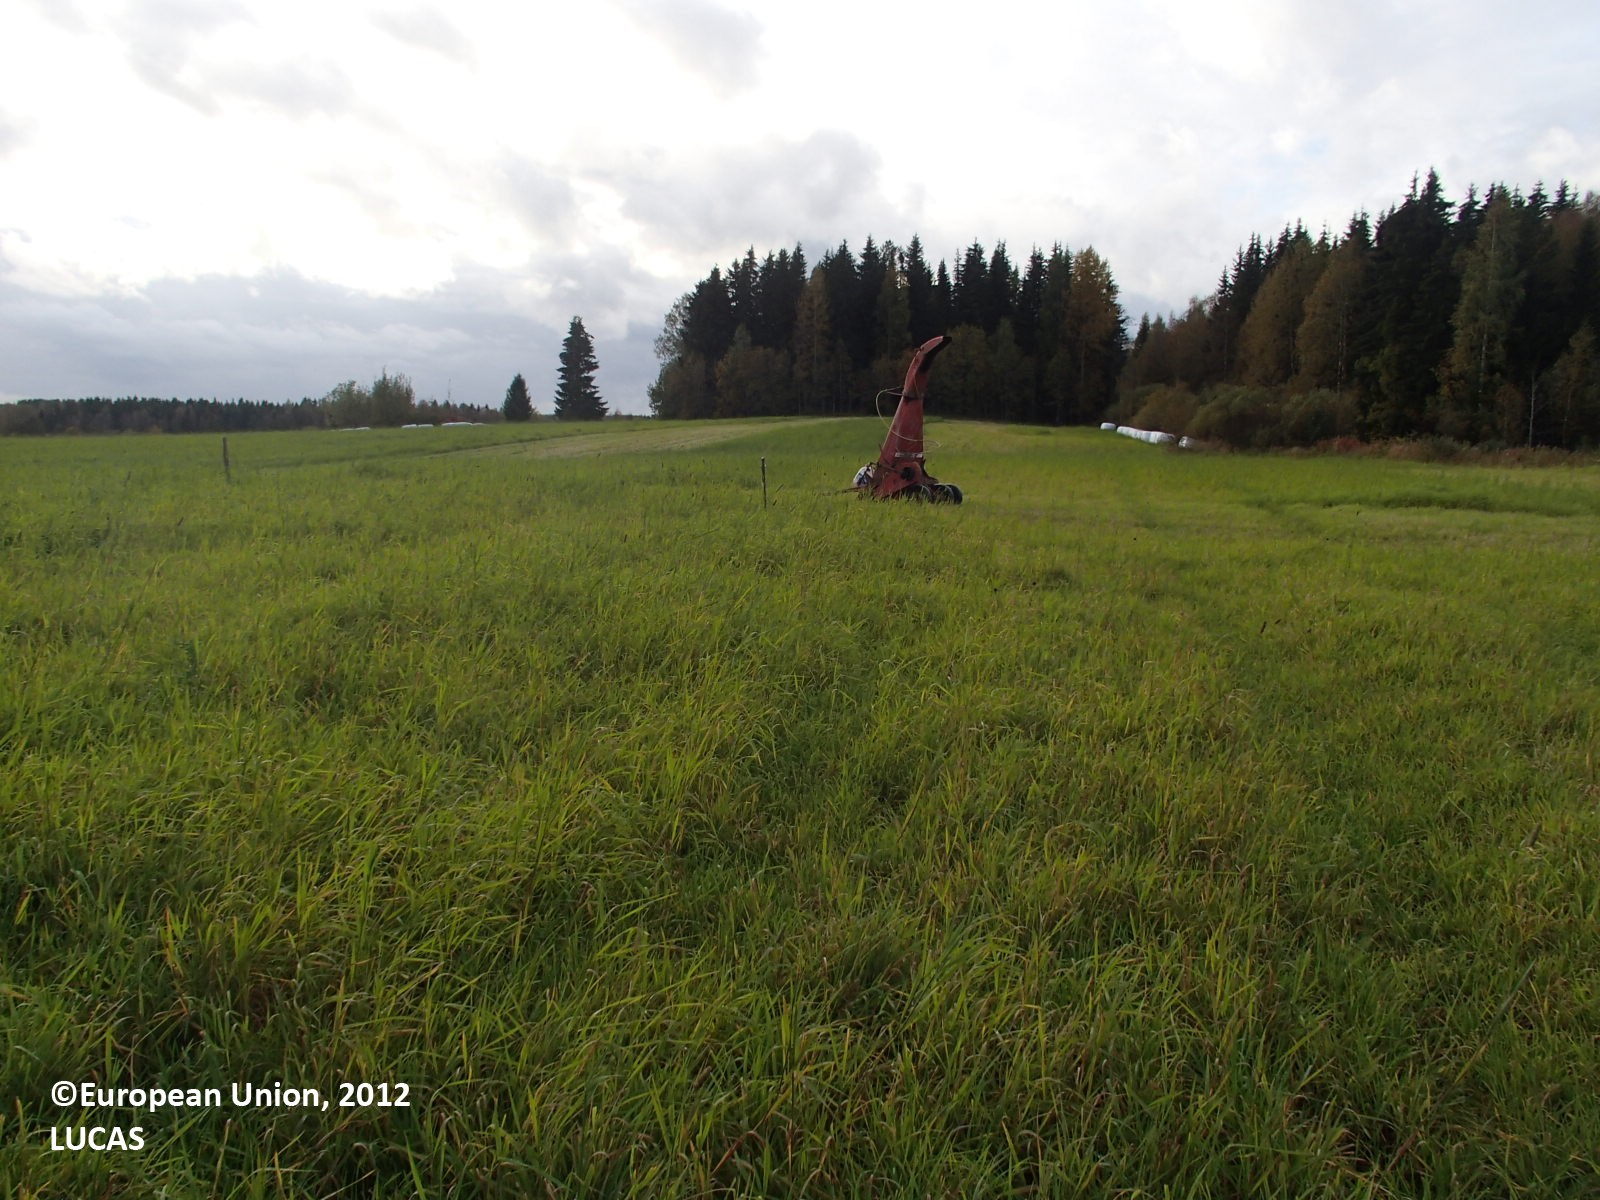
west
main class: Cropland
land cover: Temporary grasslands
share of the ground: > 75 %
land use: Agriculture (excluding fallow land and kitchen gardens)
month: September
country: FI
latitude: 63.3047
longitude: 27.9498
